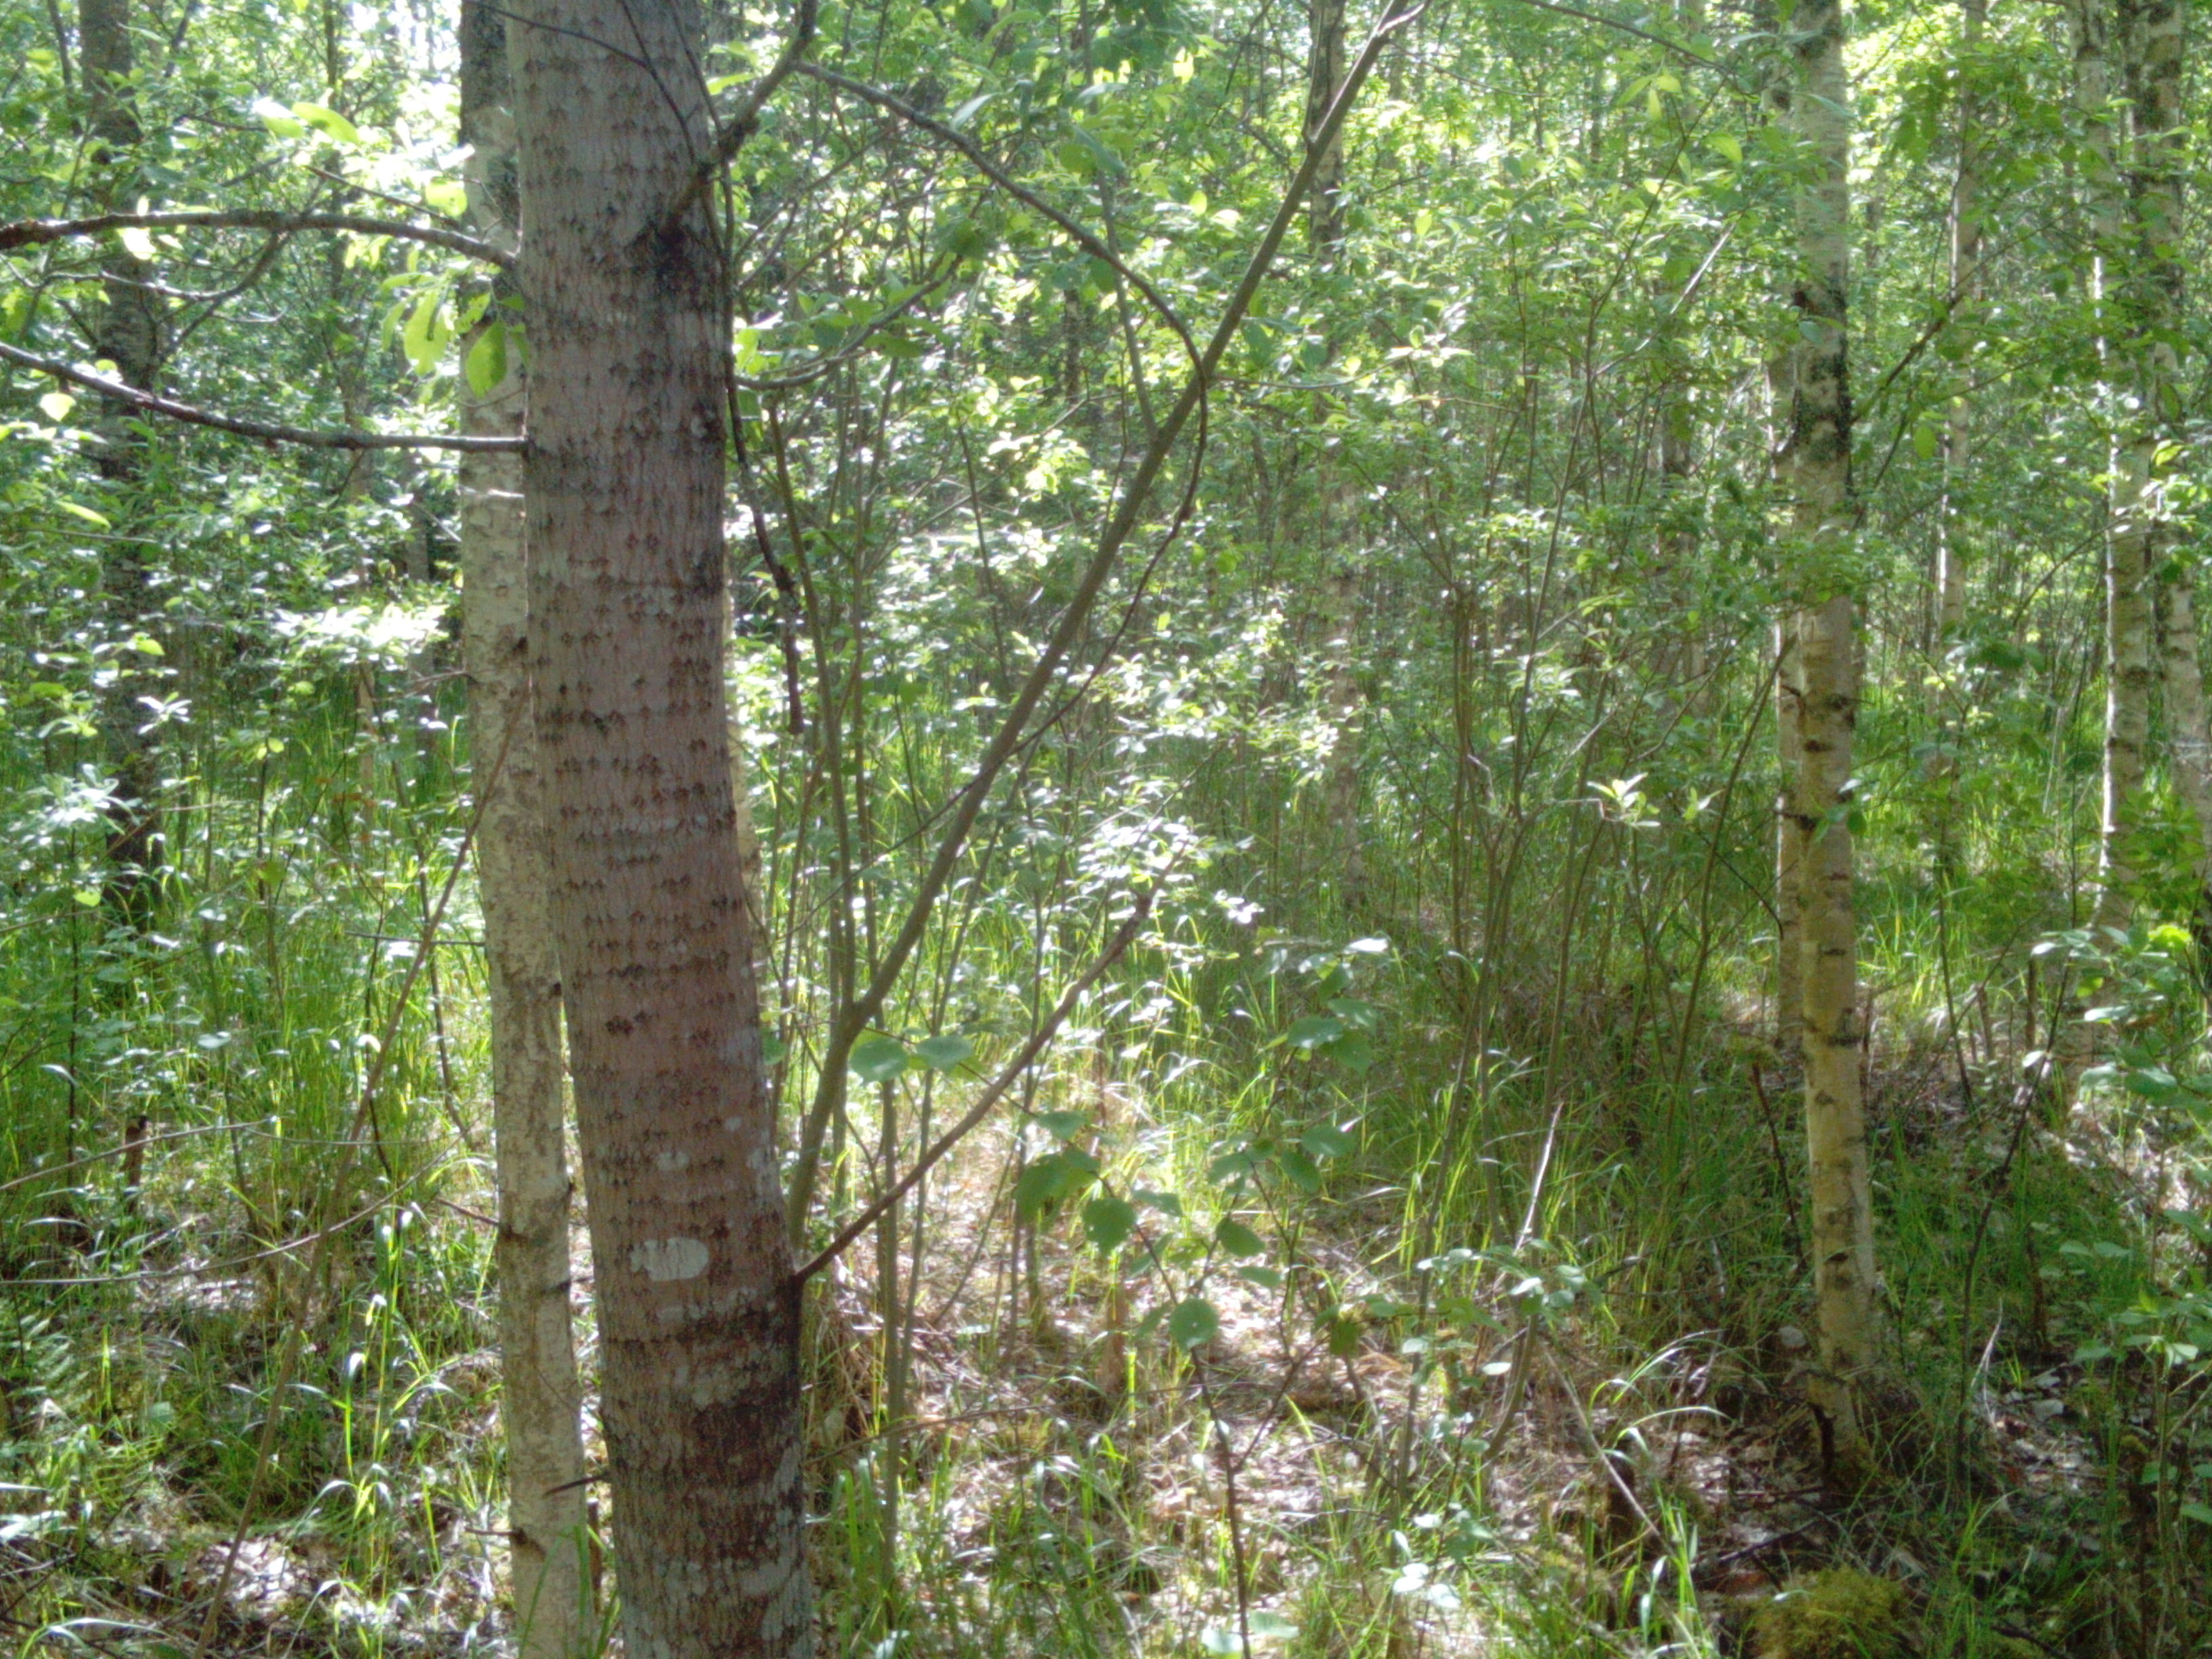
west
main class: Woodland
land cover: Broadleaved woodland
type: acidophilous oak and oak-birch forest
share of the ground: > 75 %
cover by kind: broadleaved forest trees 80 %, coniferous forest trees 15 %, herbaceous plants 5 %
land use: Forestry
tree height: > 5 m
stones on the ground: < 10 %
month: June
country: LV
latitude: 56.7086
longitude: 22.2548
